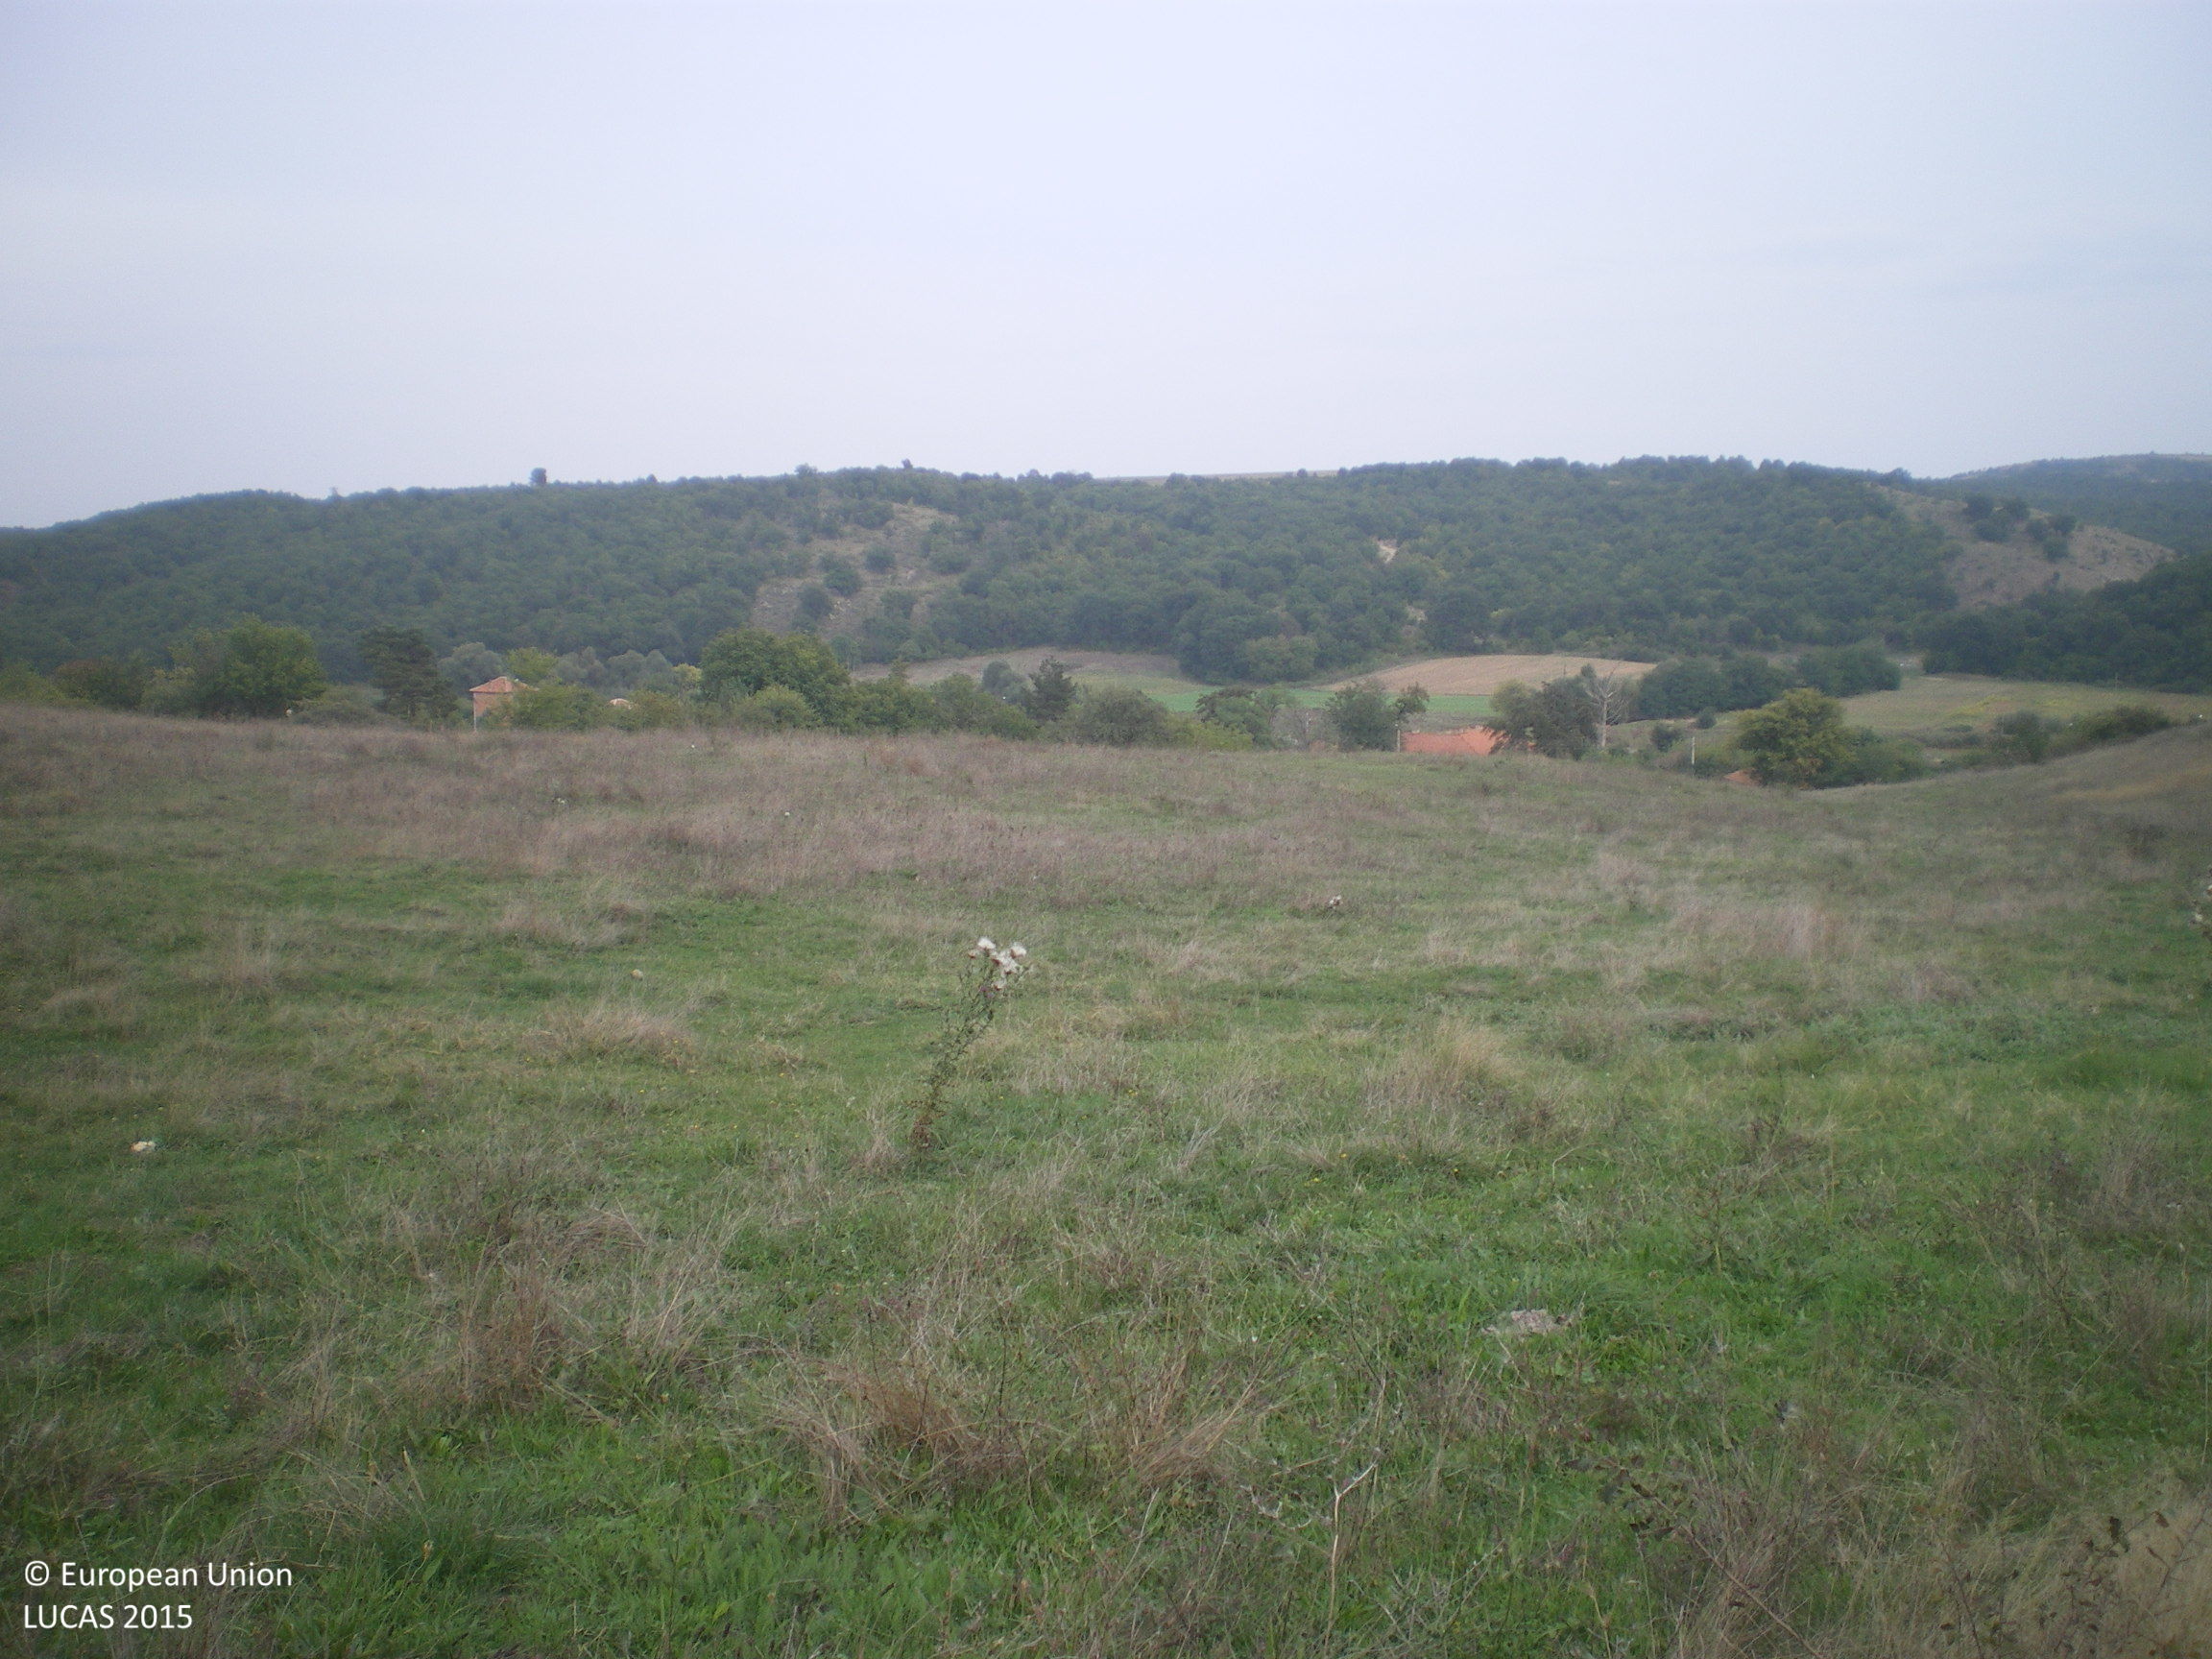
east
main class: Grassland
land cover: Grassland without tree/shrub cover
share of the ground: > 75 %
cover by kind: herbaceous plants 100 %
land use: Agriculture (excluding fallow land and kitchen gardens)
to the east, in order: Grassland without tree/shrub cover; Tracks; Grassland without tree/shrub cover; Shrubland without tree cover; Grassland without tree/shrub cover; Artificial constructions in urban areas
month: September
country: BG
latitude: 41.8467
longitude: 25.9082
